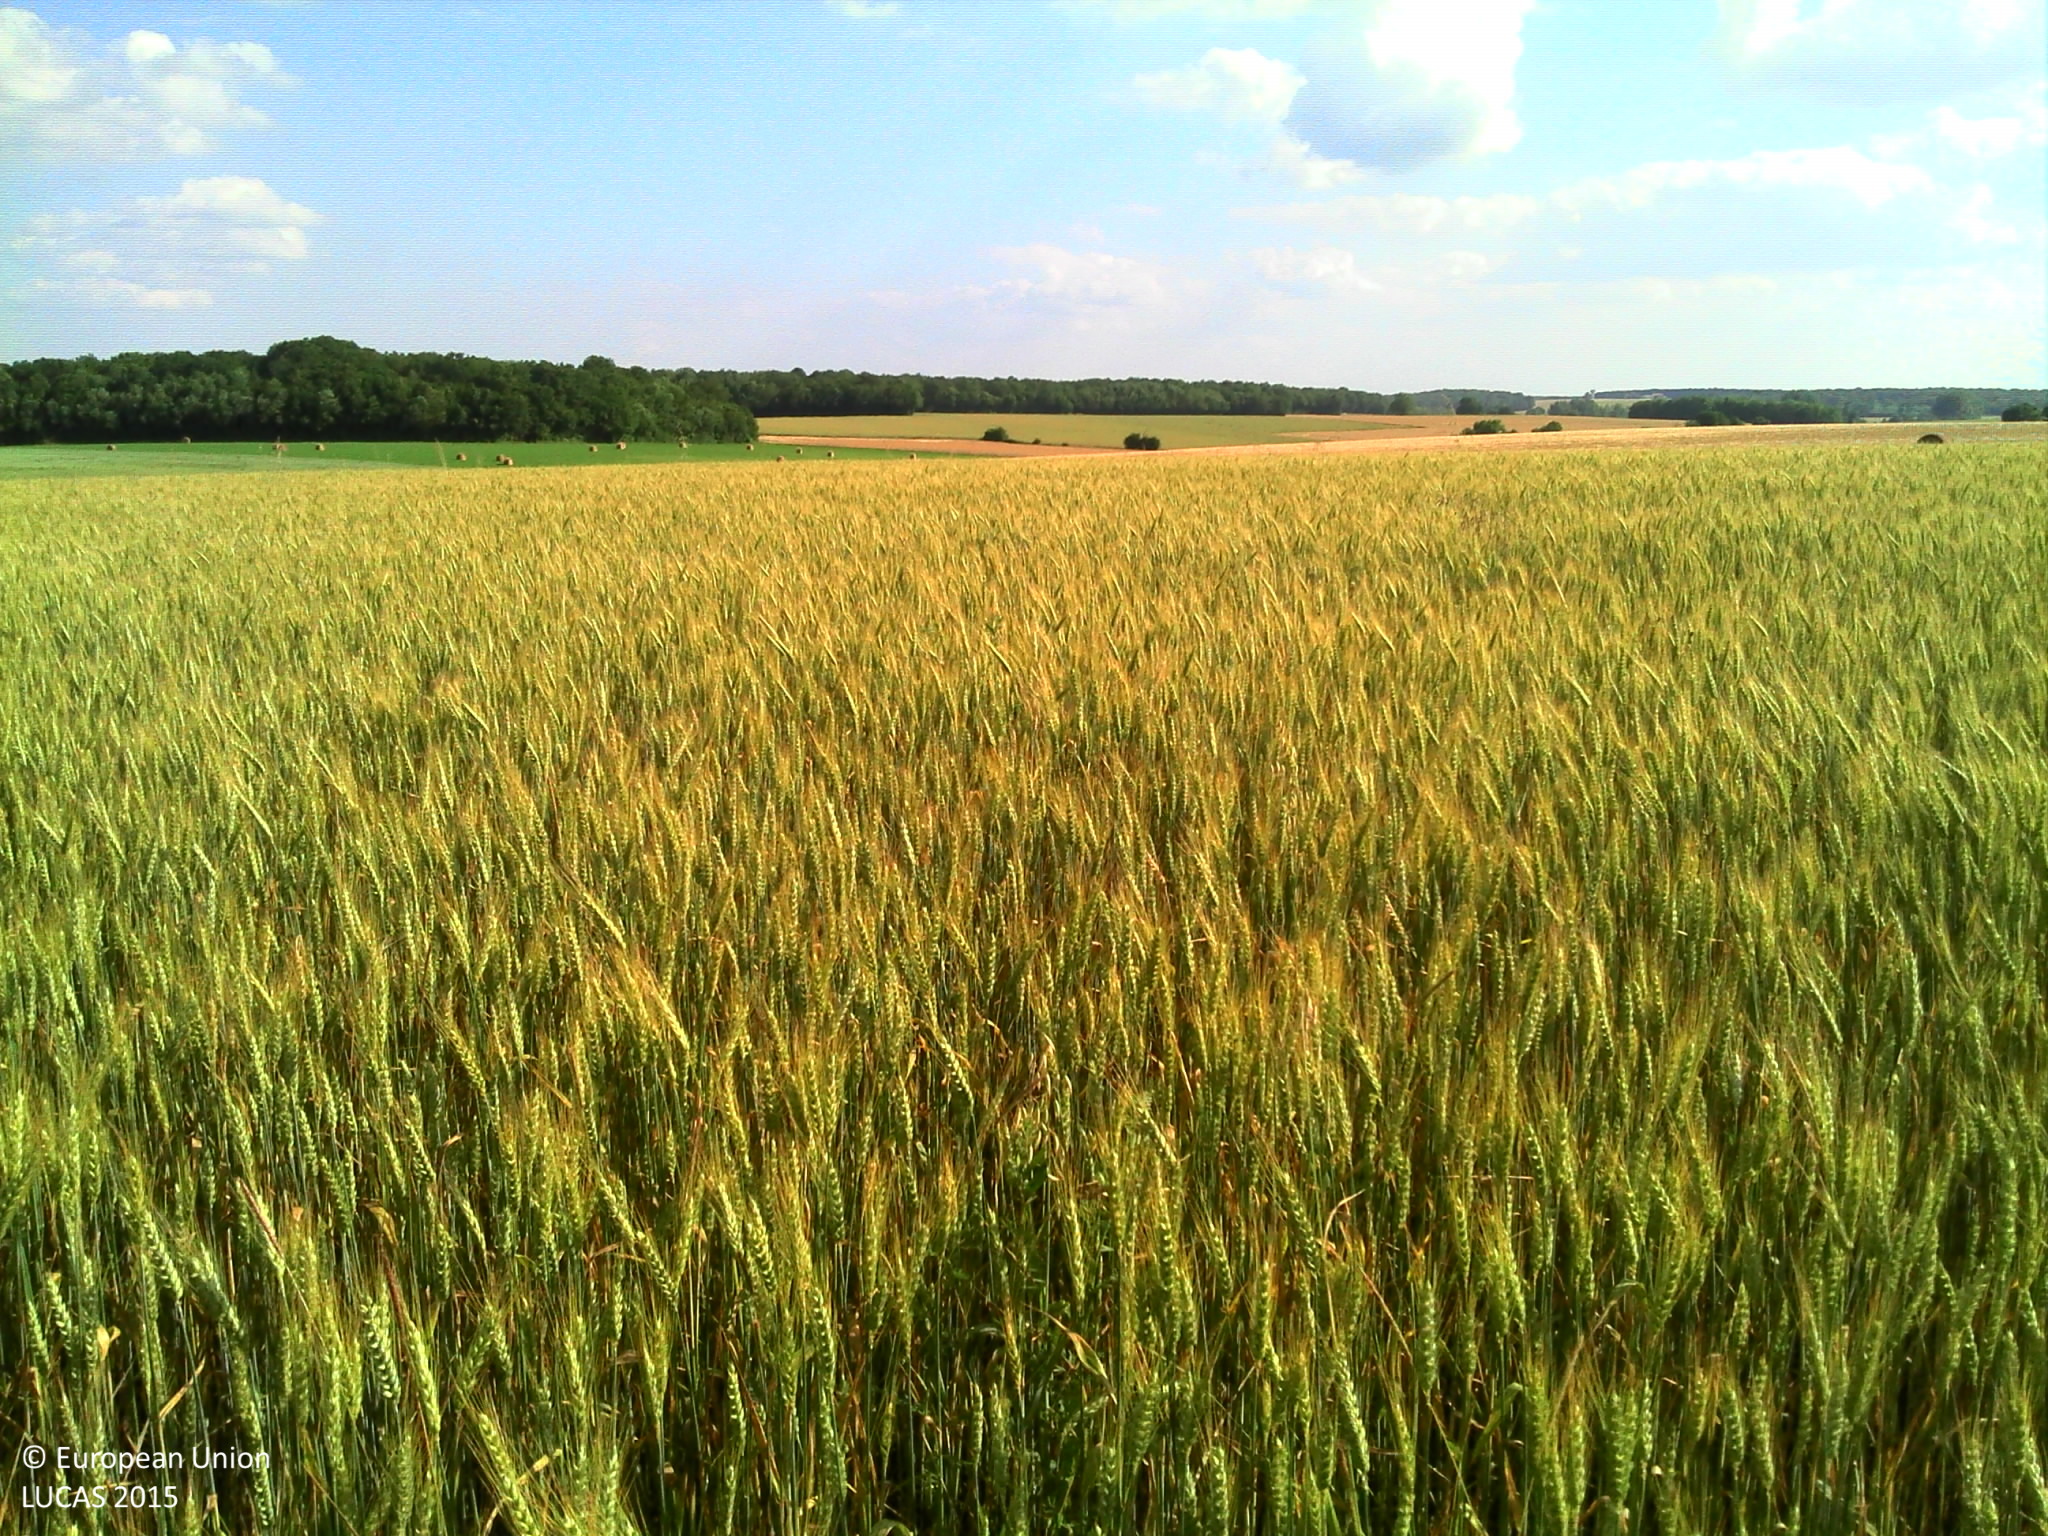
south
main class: Cropland
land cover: Common wheat
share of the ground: > 75 %
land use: Agriculture (excluding fallow land and kitchen gardens)
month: June
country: FR
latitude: 47.4173
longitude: 3.1957
